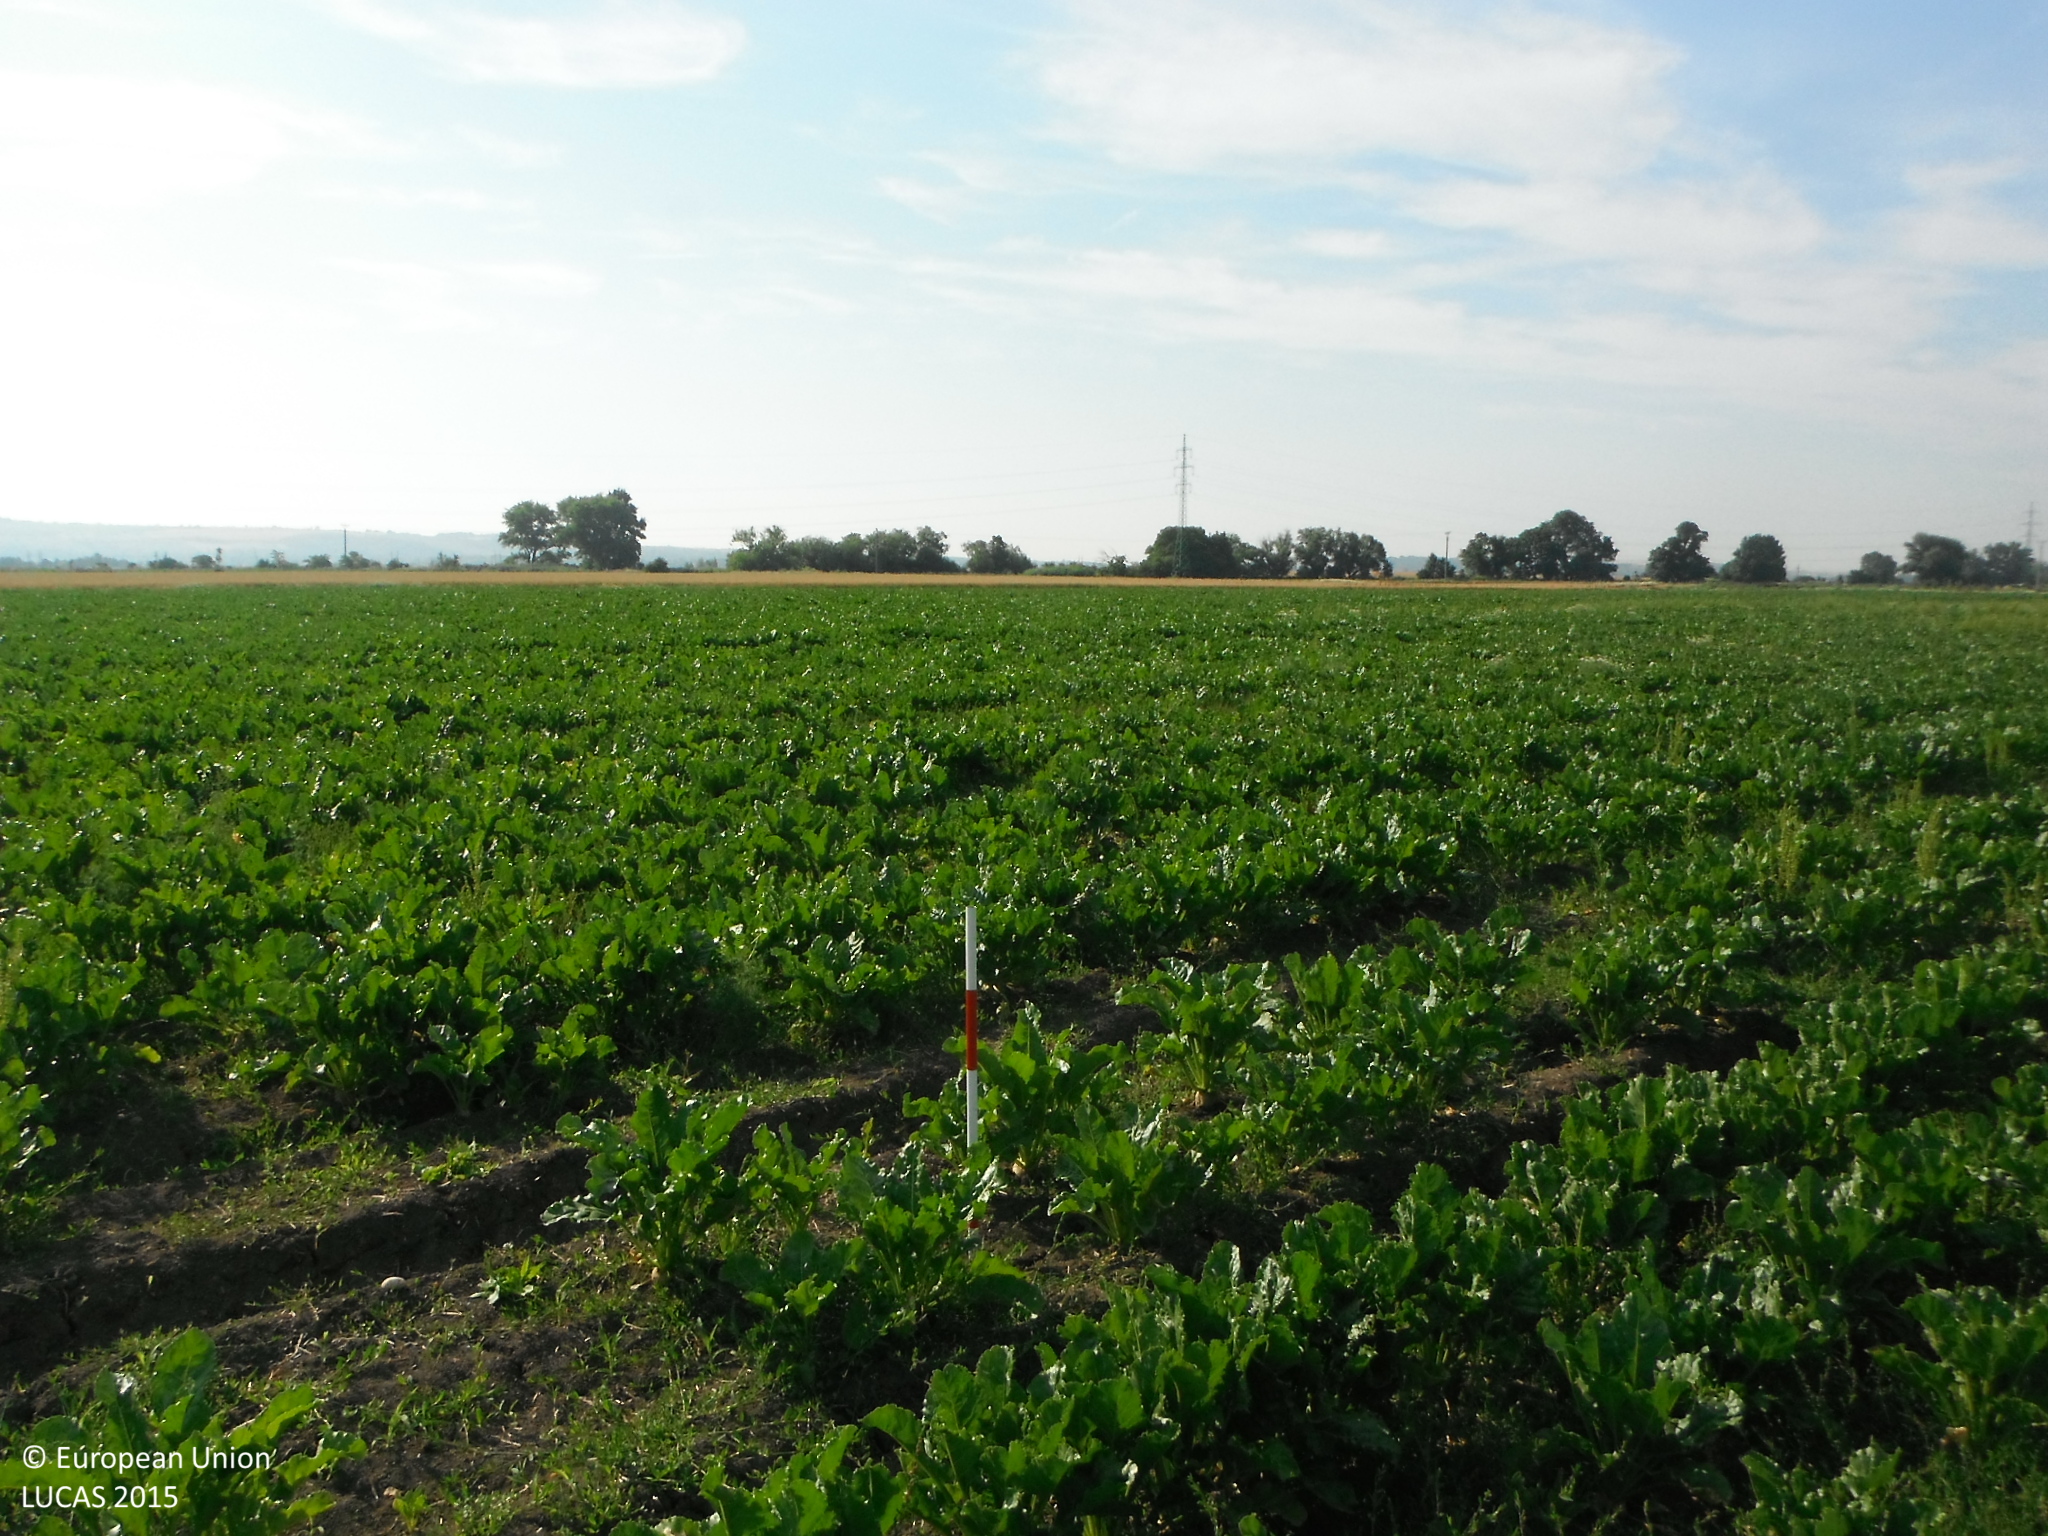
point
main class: Cropland
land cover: Sugar beet
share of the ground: > 75 %
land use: Agriculture (excluding fallow land and kitchen gardens)
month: June
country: SK
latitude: 48.4220
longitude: 17.7277
